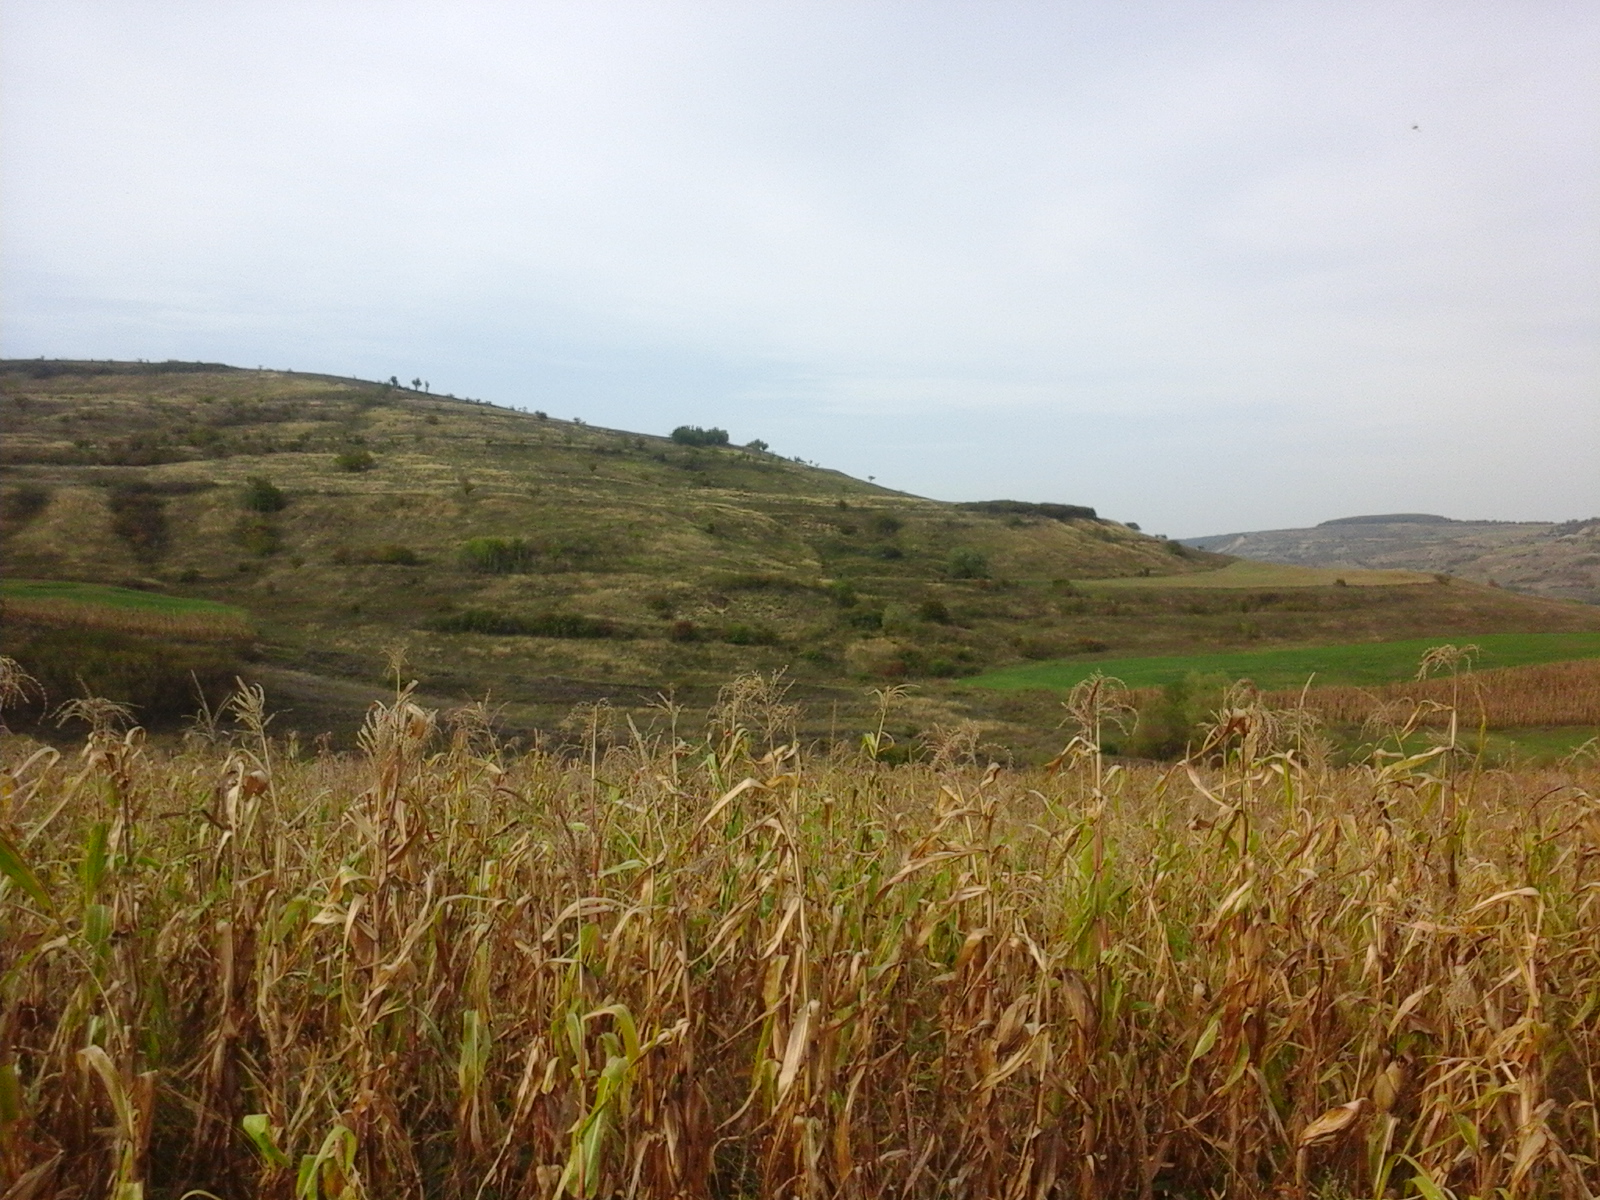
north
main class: Cropland
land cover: Maize
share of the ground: > 75 %
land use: Agriculture (excluding fallow land and kitchen gardens)
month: September
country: RO
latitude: 46.9712
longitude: 24.1872
